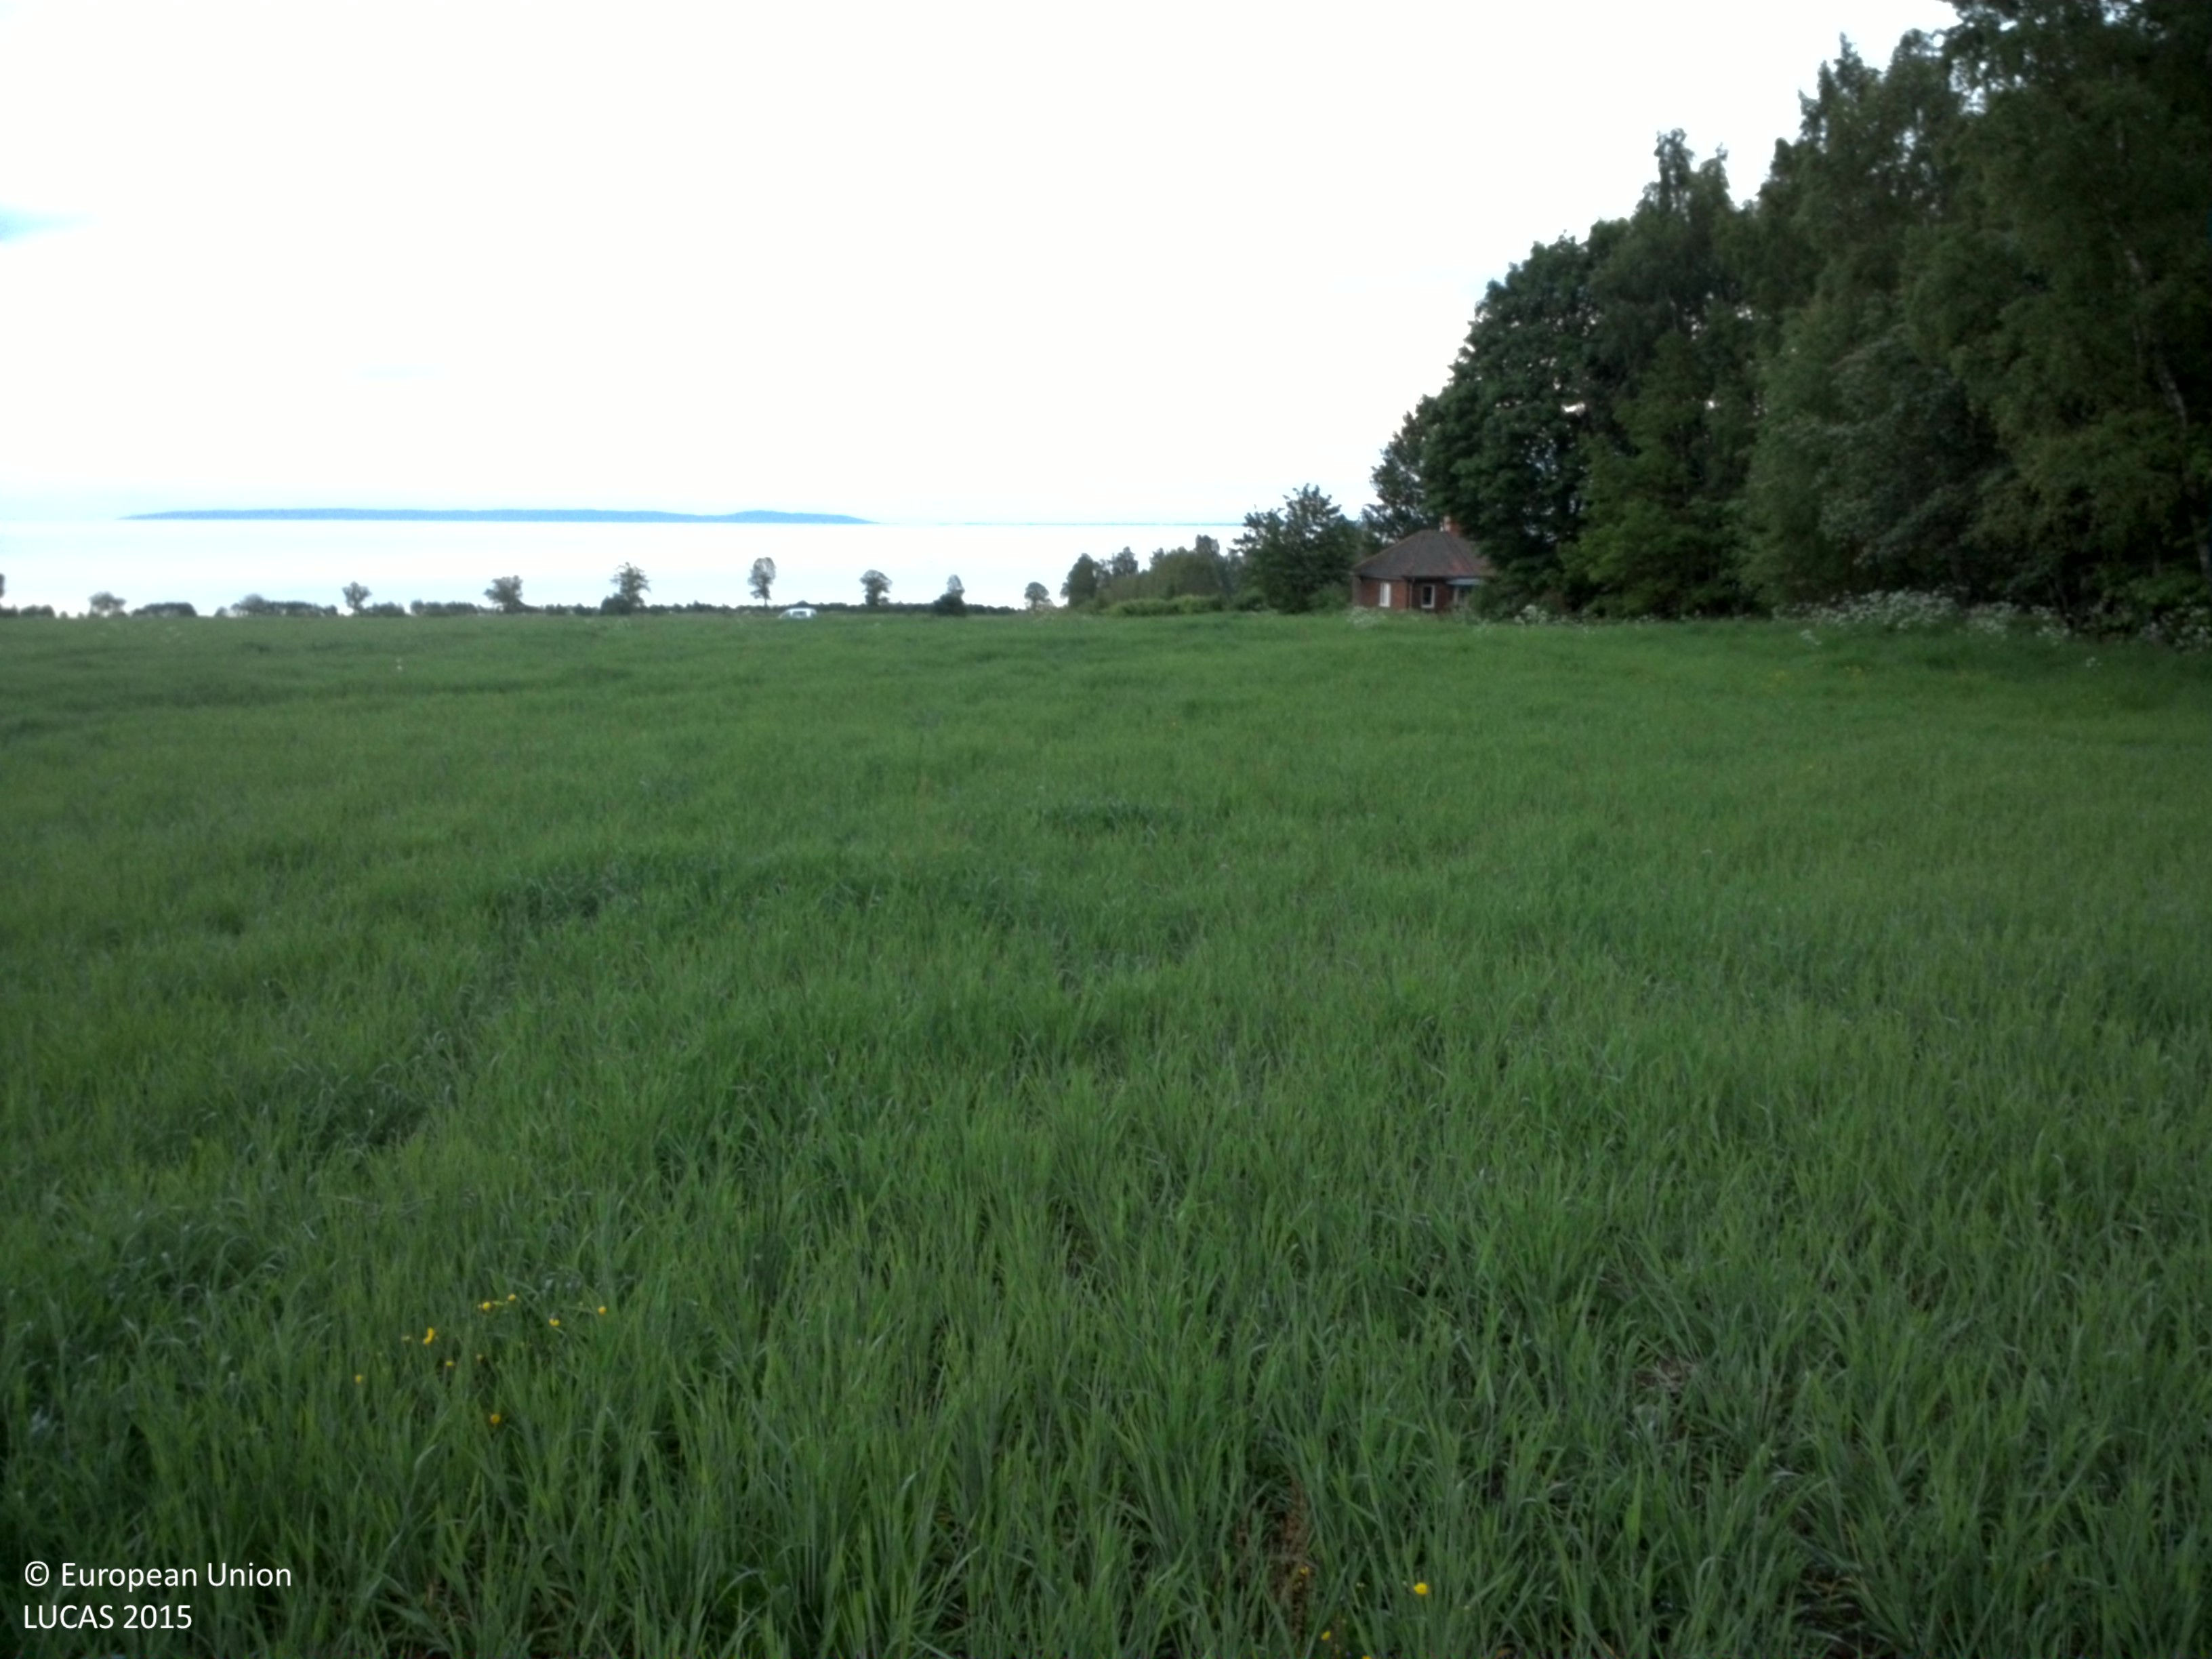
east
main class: Cropland
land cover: Barley
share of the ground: > 75 %
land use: Agriculture (excluding fallow land and kitchen gardens)
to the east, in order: Barley; Spontaneously vegetated surfaces; Ditches and canals; Paved roads, cycling and walking lanes; Spontaneously vegetated surfaces; Grassland without tree/shrub cover
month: June
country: SE
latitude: 58.2777
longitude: 14.2739
